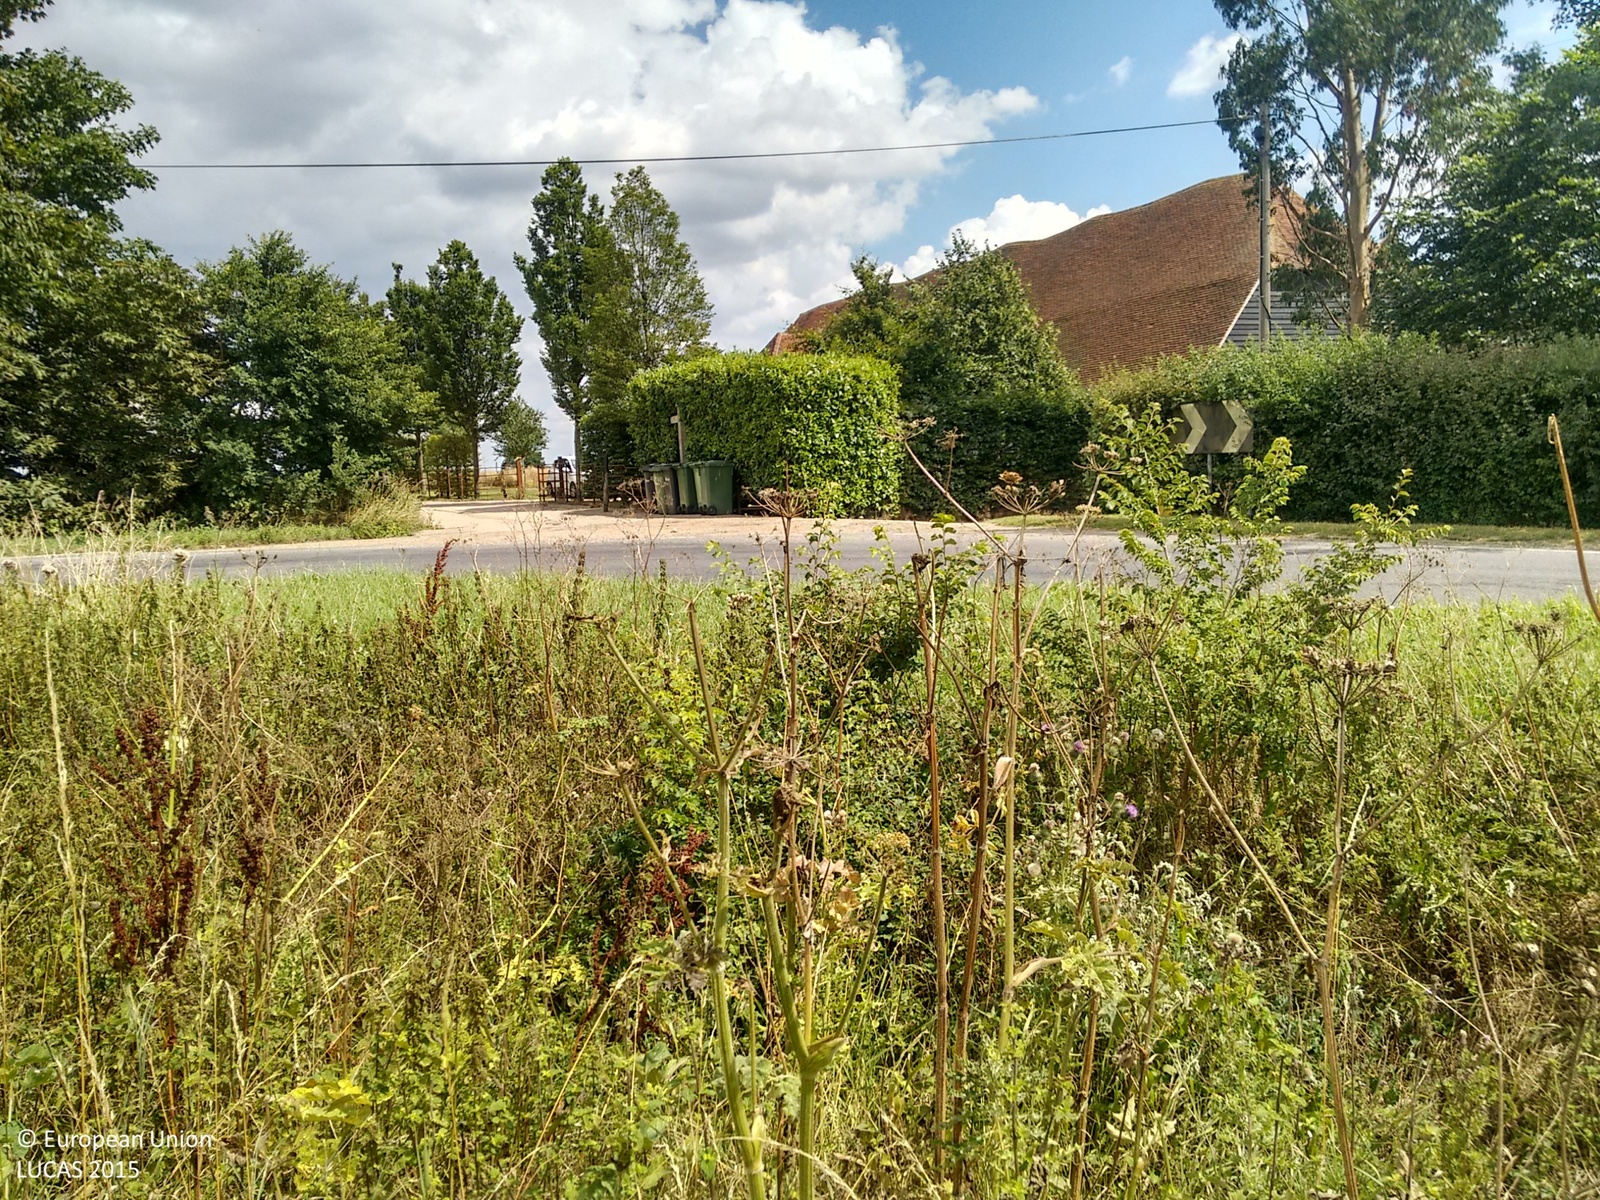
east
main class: Cropland
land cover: Rape and turnip rape
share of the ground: > 75 %
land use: Agriculture (excluding fallow land and kitchen gardens)
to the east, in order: Rape and turnip rape; Grassland without tree/shrub cover; Ditches and canals; Grassland without tree/shrub cover; Artificial constructions in urban areas; Grass margins; Rape and turnip rape; Maize; Shrubland without tree cover; Ditches and canals; Shrubland without tree cover; Grassland without tree/shrub cover
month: July
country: GB
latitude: 51.9036
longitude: 0.4810
